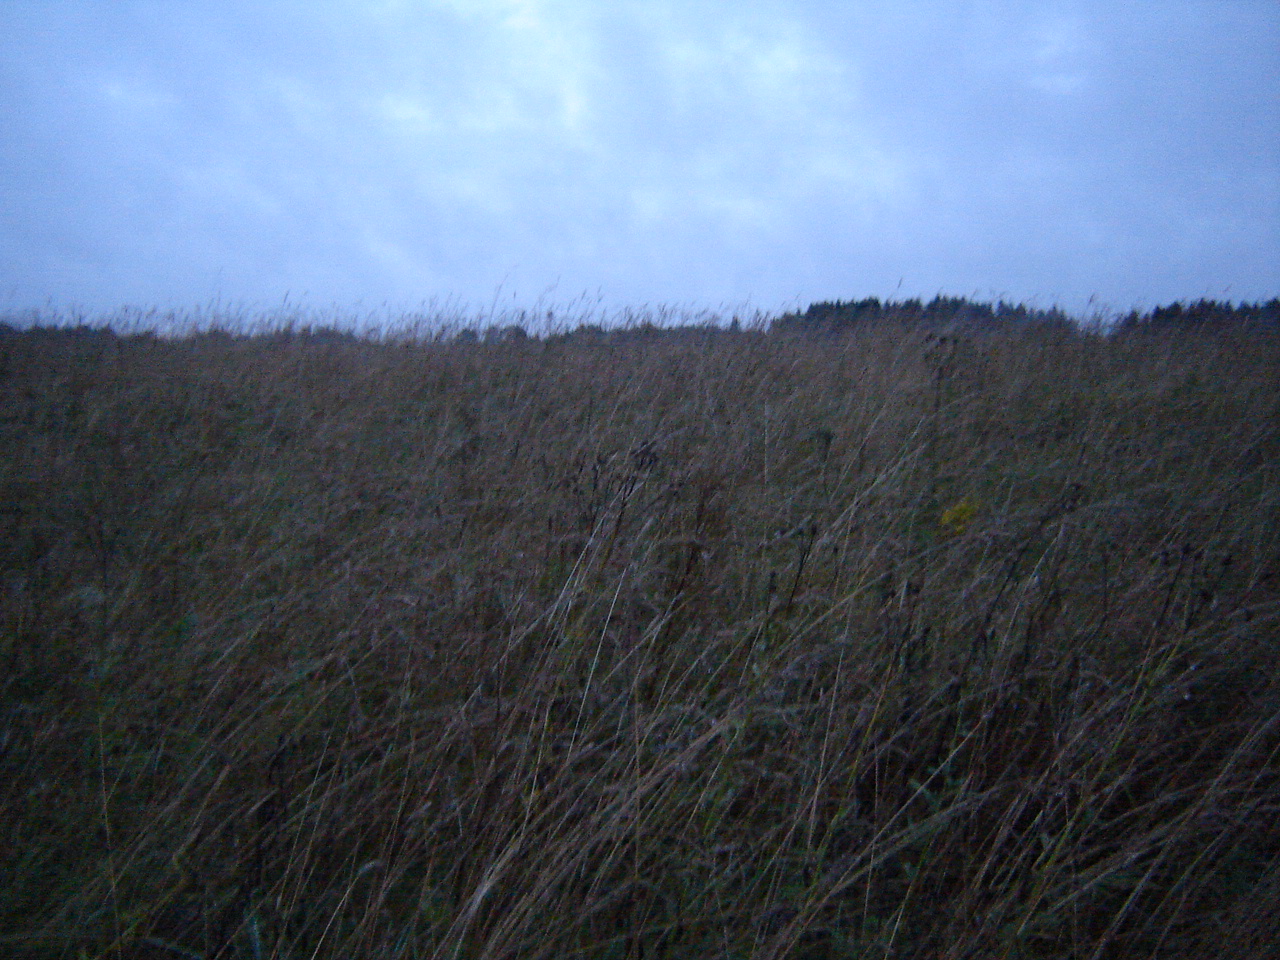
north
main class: Grassland
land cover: Spontaneously vegetated surfaces
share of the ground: > 75 %
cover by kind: herbaceous plants 100 %
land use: Fallow land
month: September
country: LT
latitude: 54.9276
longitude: 25.3368
